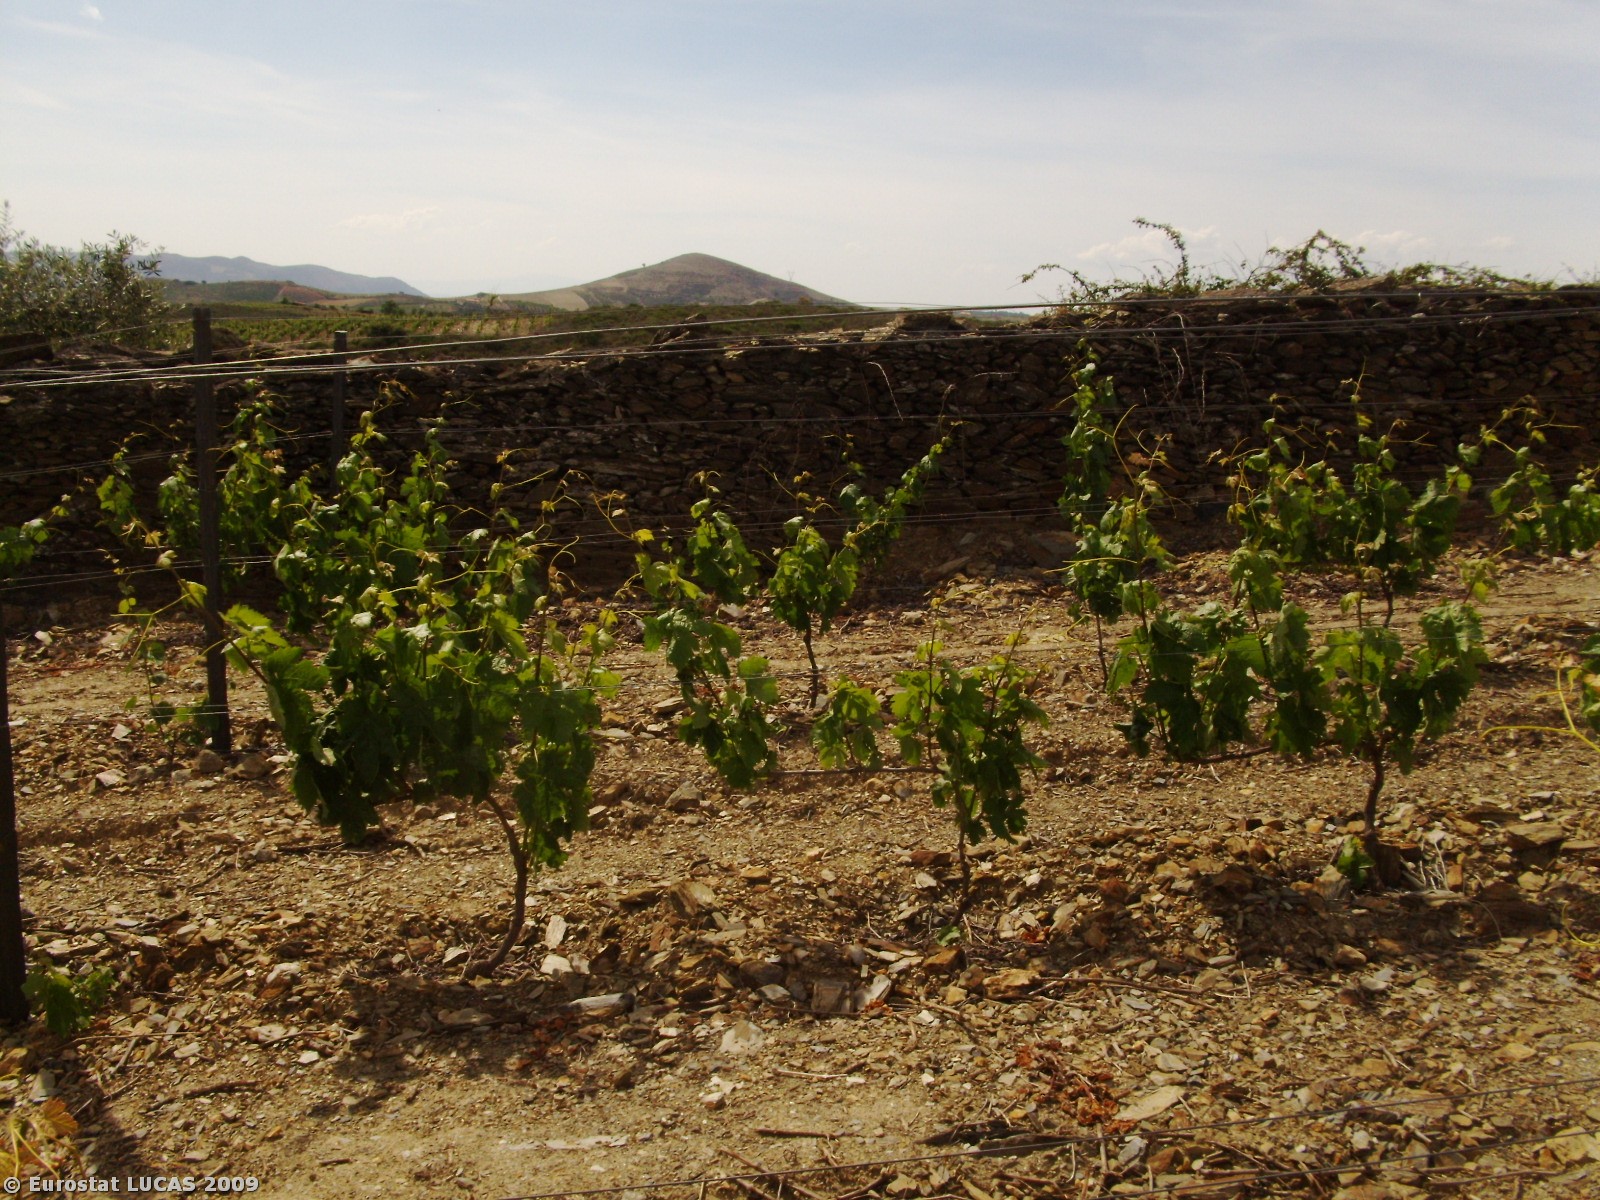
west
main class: Cropland
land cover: Vineyards
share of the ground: 25 - 50 %
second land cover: Bare land
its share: 50 - 75 %
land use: Agriculture (excluding fallow land and kitchen gardens)
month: May
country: PT
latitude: 41.1335
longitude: -7.4041
